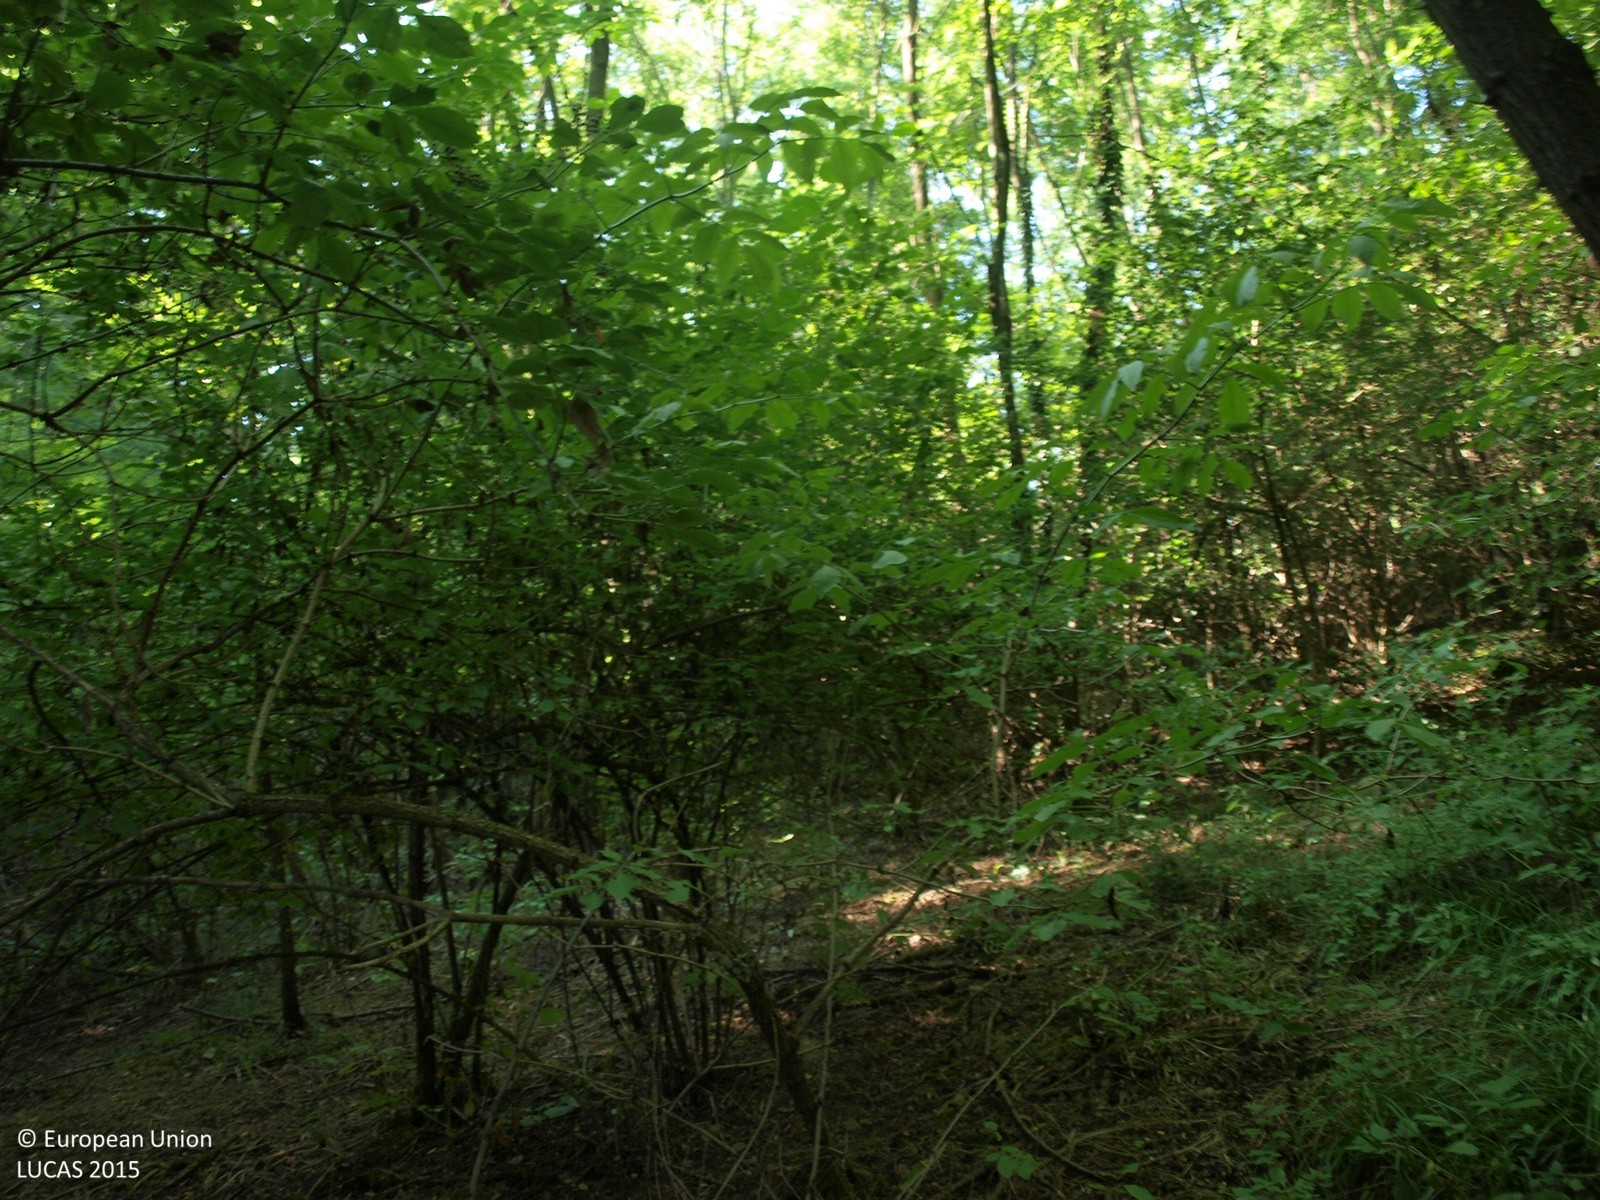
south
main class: Woodland
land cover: Broadleaved woodland
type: mesophytic deciduous forest
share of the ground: > 75 %
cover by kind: broadleaved forest trees 100 %
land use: Forestry
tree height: > 5 m
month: August
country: HR
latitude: 45.9795
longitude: 16.3886
